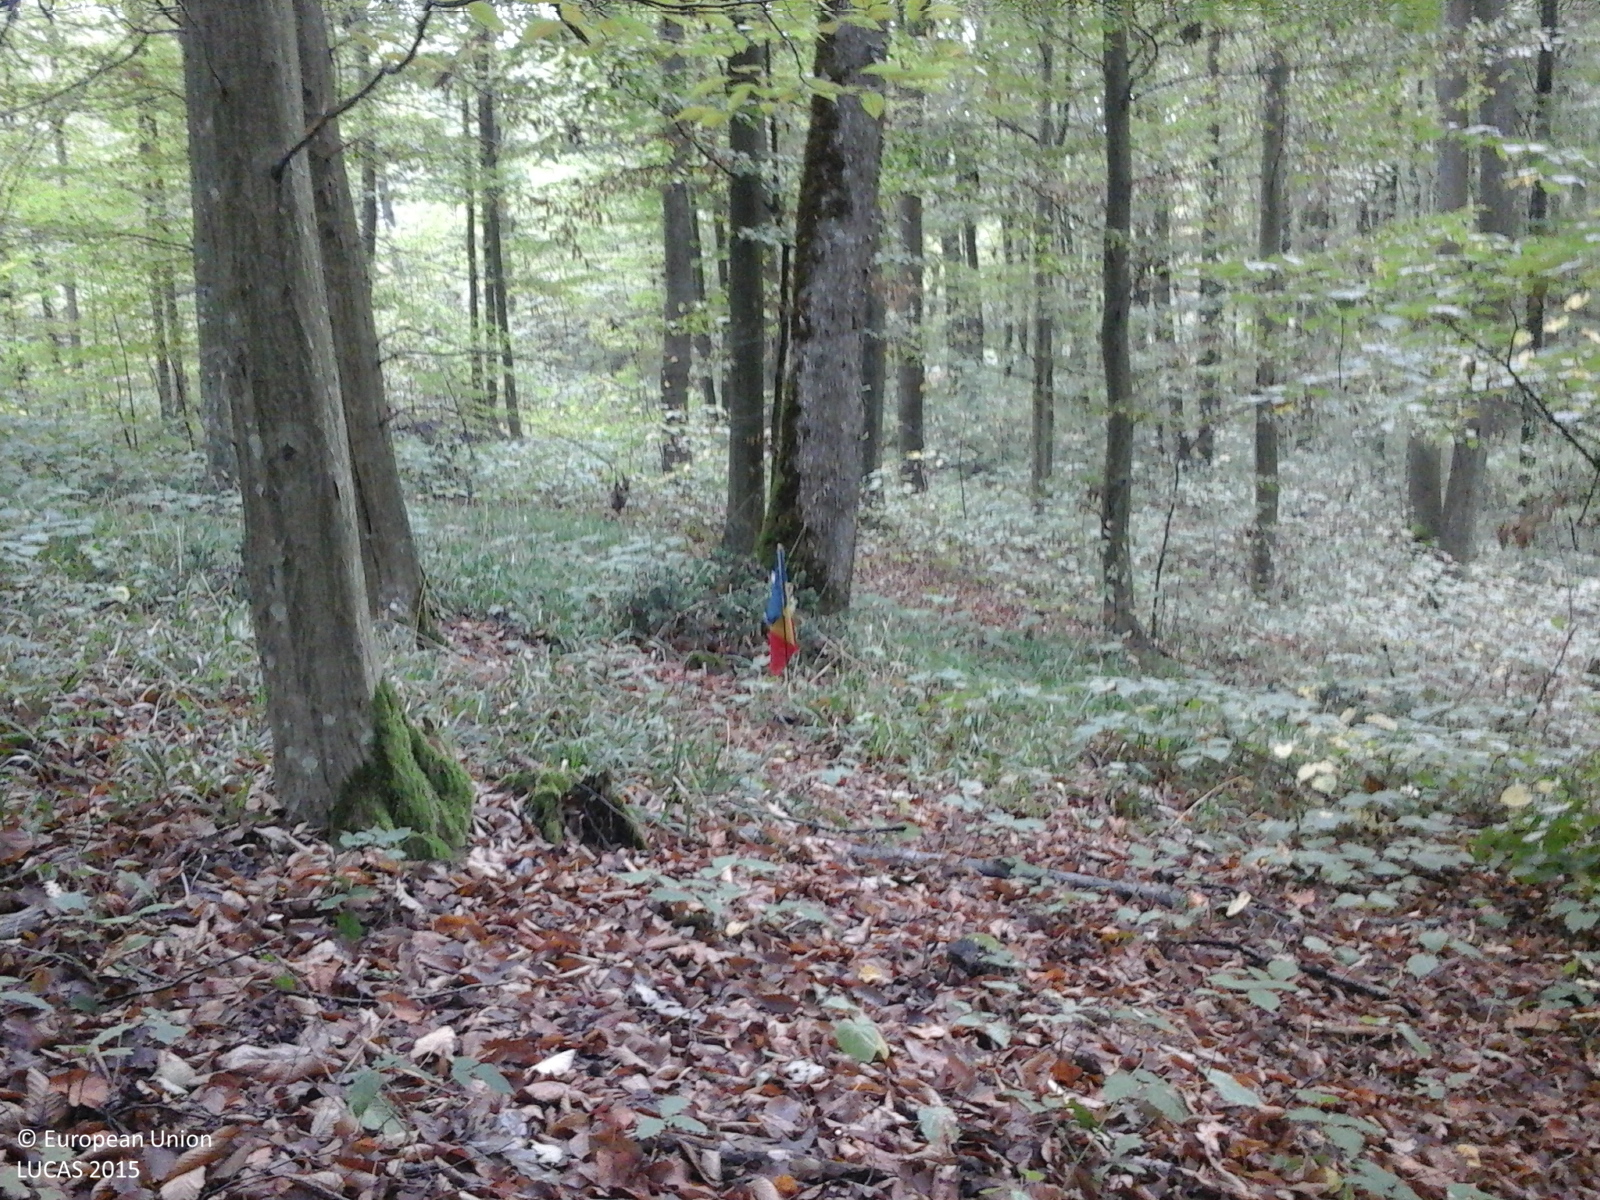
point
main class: Woodland
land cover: Broadleaved woodland
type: mesophytic deciduous forest
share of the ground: > 75 %
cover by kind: broadleaved forest trees 100 %
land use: Forestry
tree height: > 5 m
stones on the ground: 10 - 25 %
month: September
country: RO
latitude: 45.9049
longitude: 22.1993
